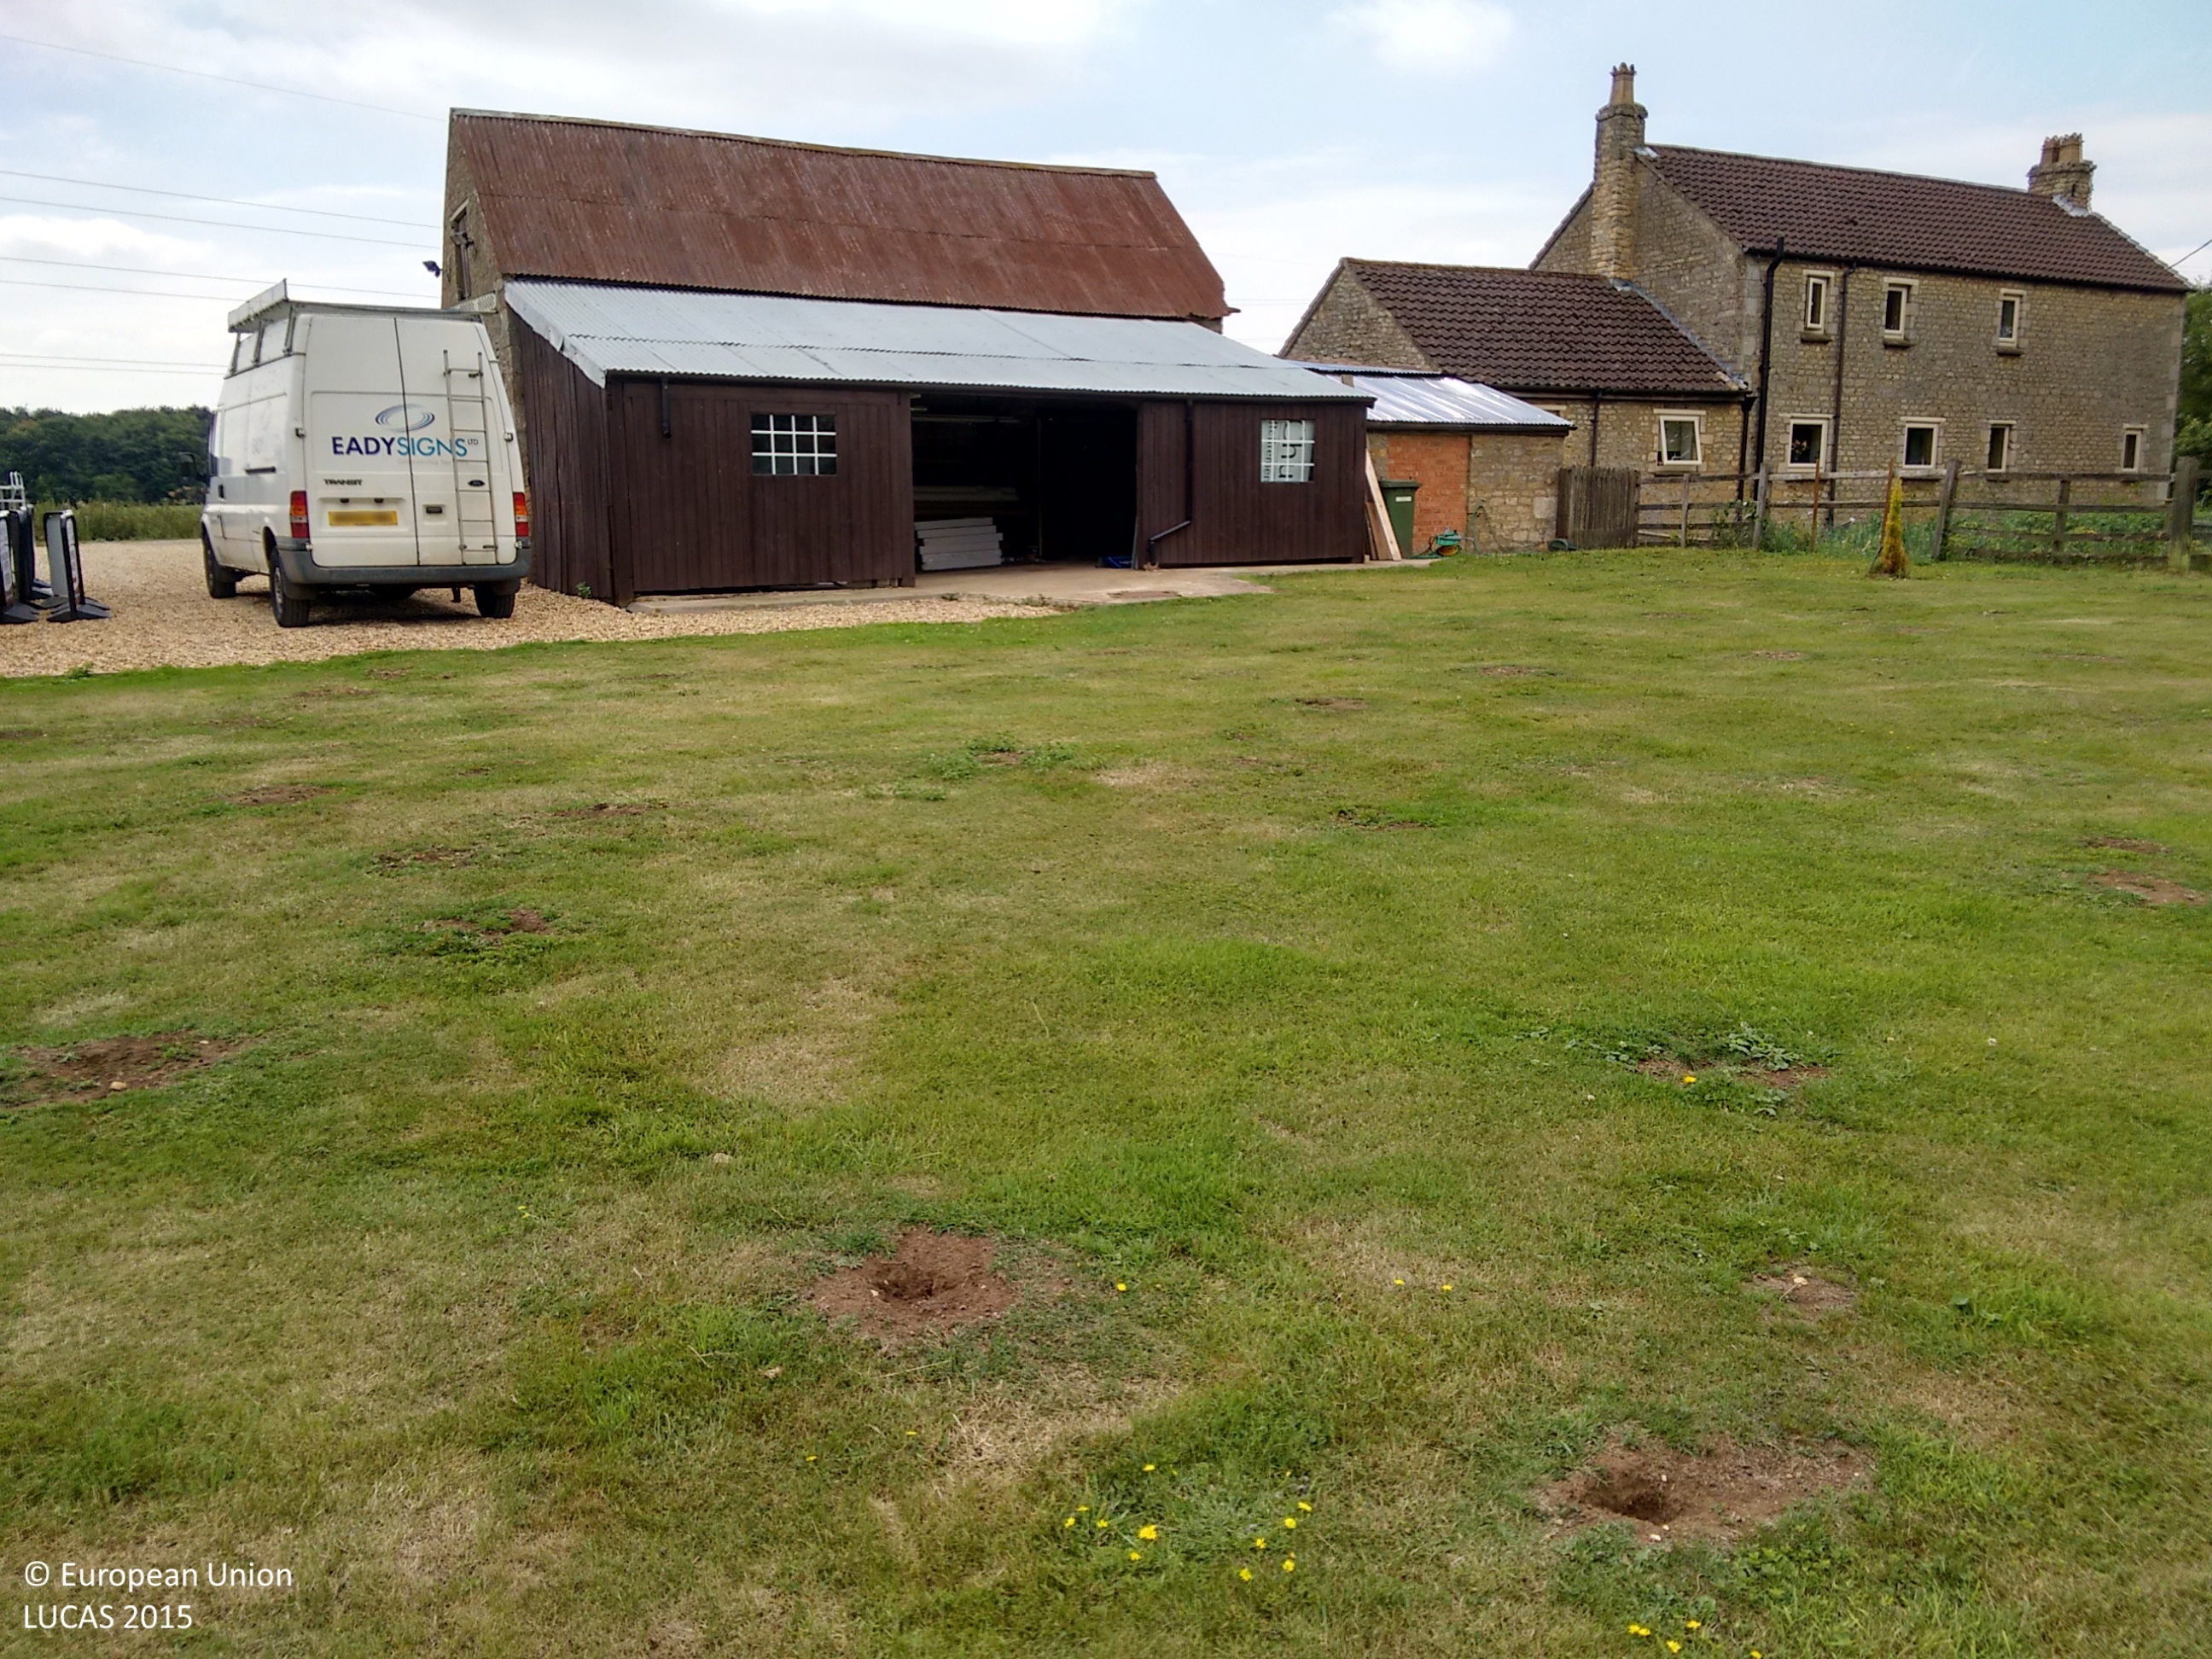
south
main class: Grassland
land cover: Grassland without tree/shrub cover
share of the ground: > 75 %
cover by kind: herbaceous plants 100 %
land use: Residential
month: July
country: GB
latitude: 52.4335
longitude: -0.7340
